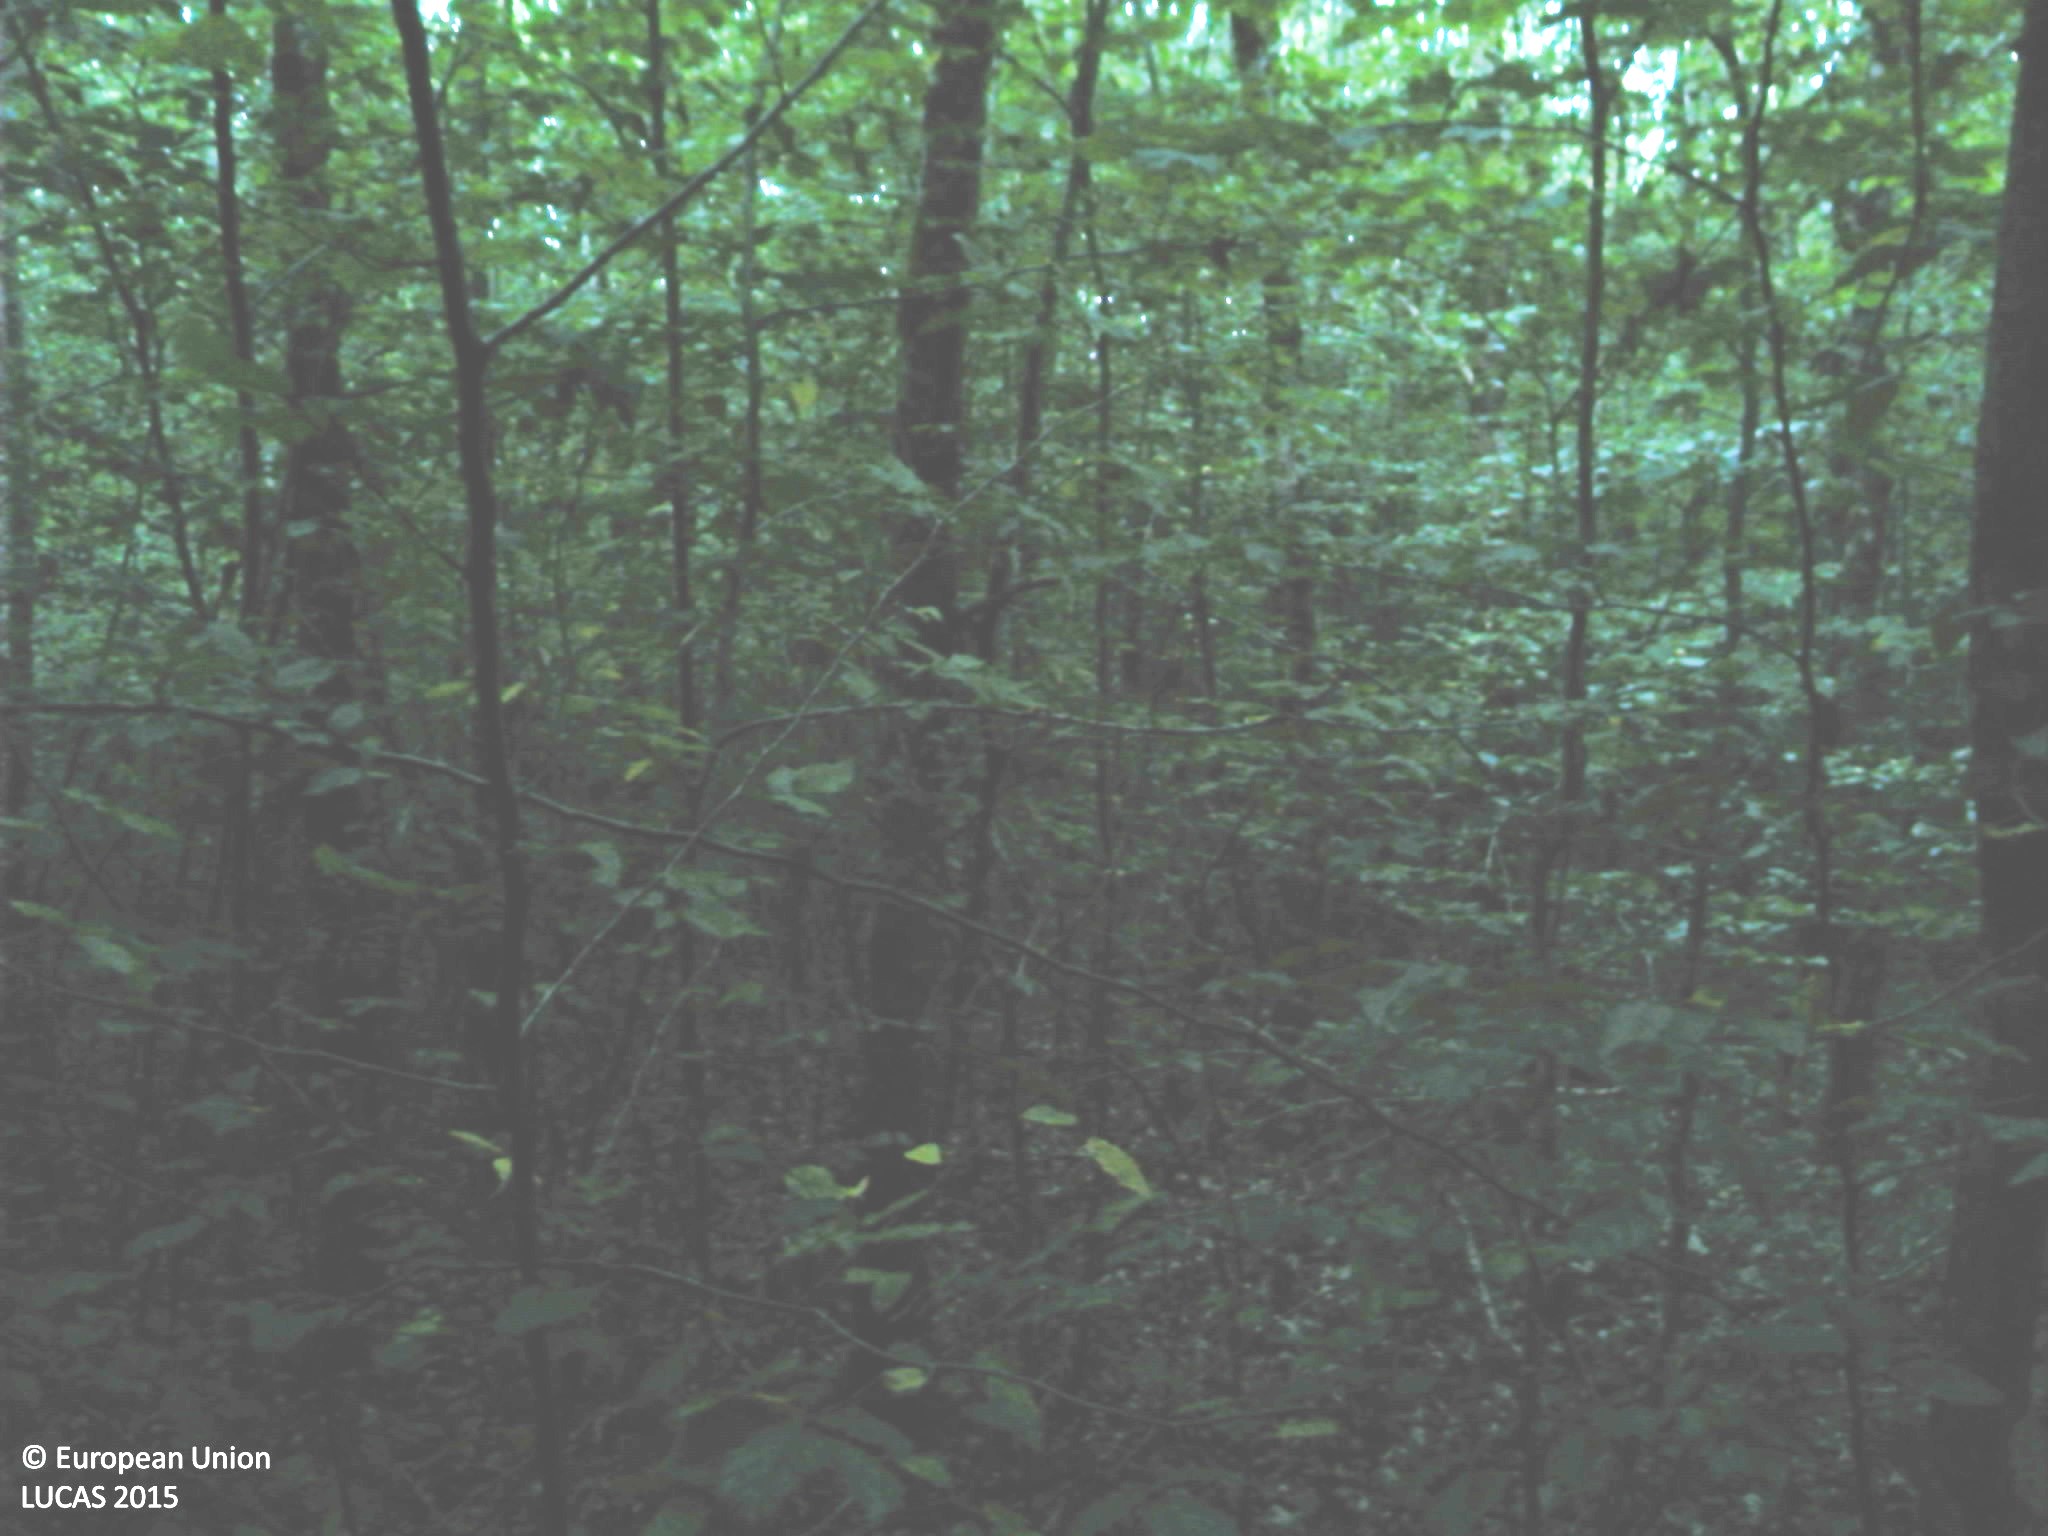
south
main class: Woodland
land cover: Broadleaved woodland
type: beech forest
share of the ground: > 75 %
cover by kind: broadleaved forest trees 90 %, unconsolidated bare surface 10 %
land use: Forestry
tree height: > 5 m
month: July
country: FR
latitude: 48.0643
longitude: 6.0956
